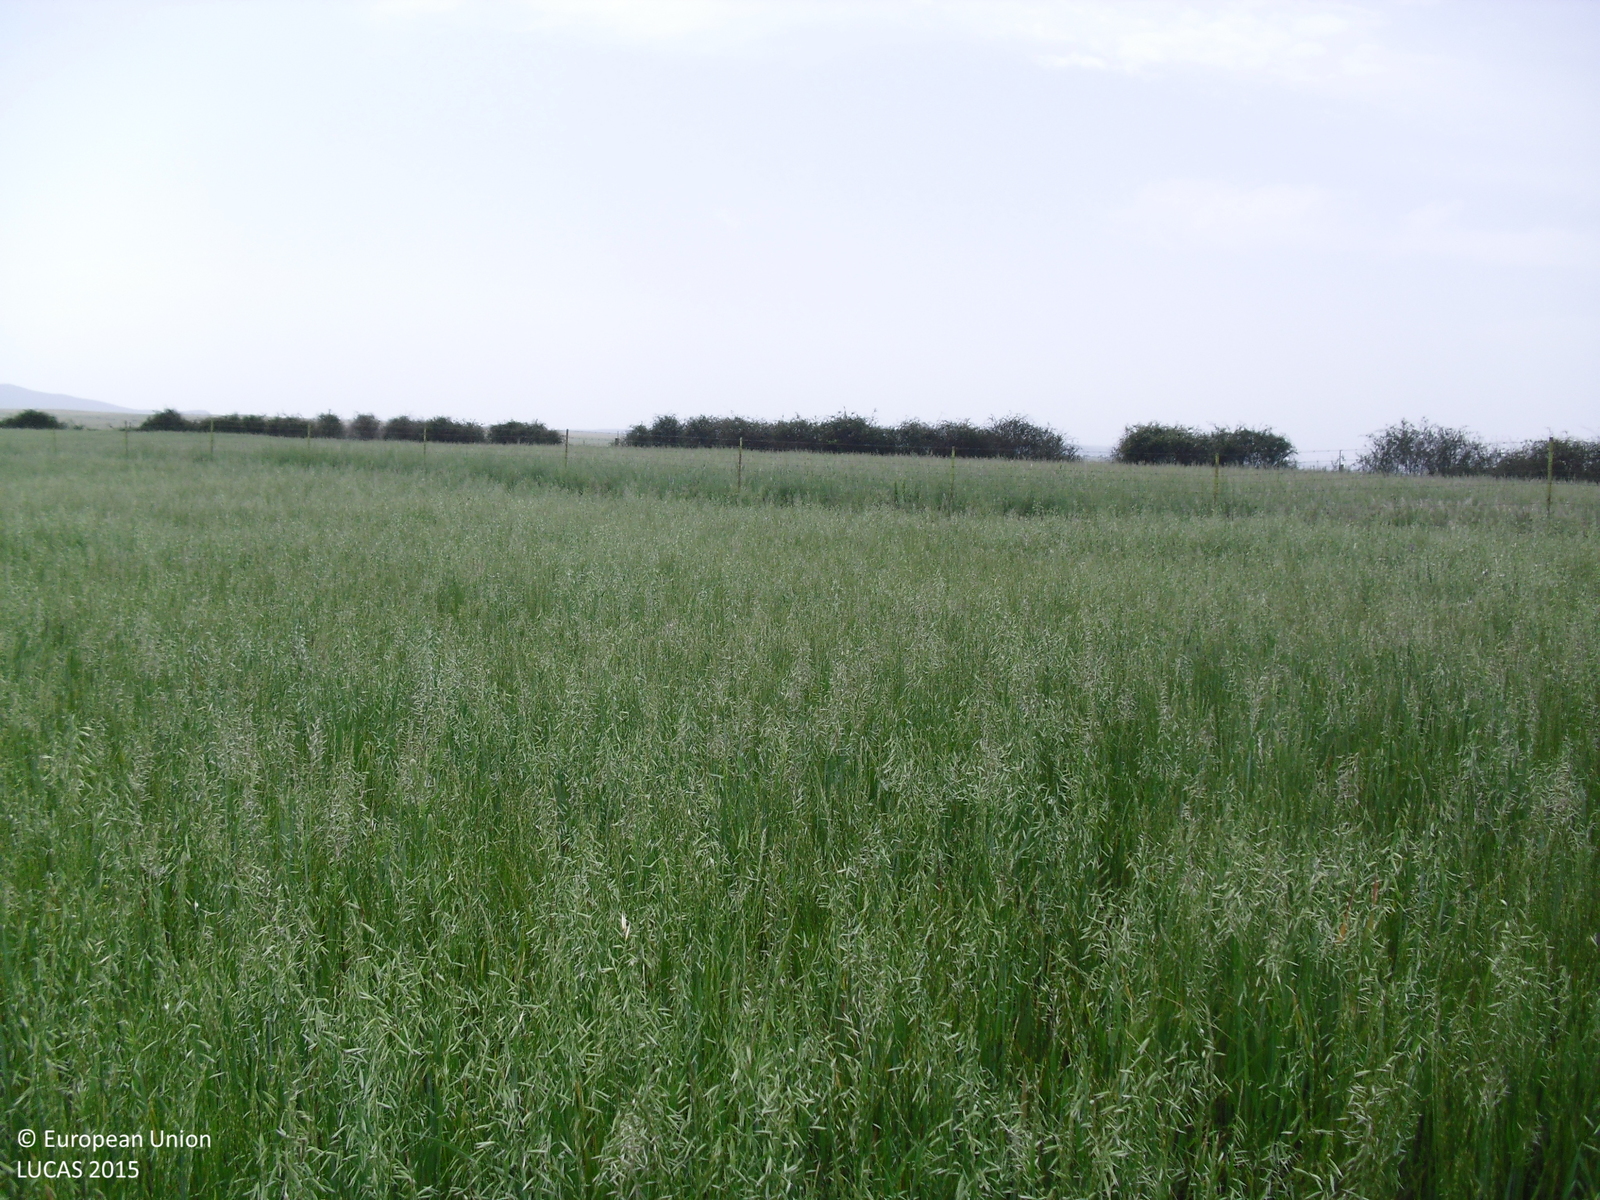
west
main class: Cropland
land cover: Oats
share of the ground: > 75 %
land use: Agriculture (excluding fallow land and kitchen gardens)
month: April
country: ES
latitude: 39.3780
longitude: -6.3766
